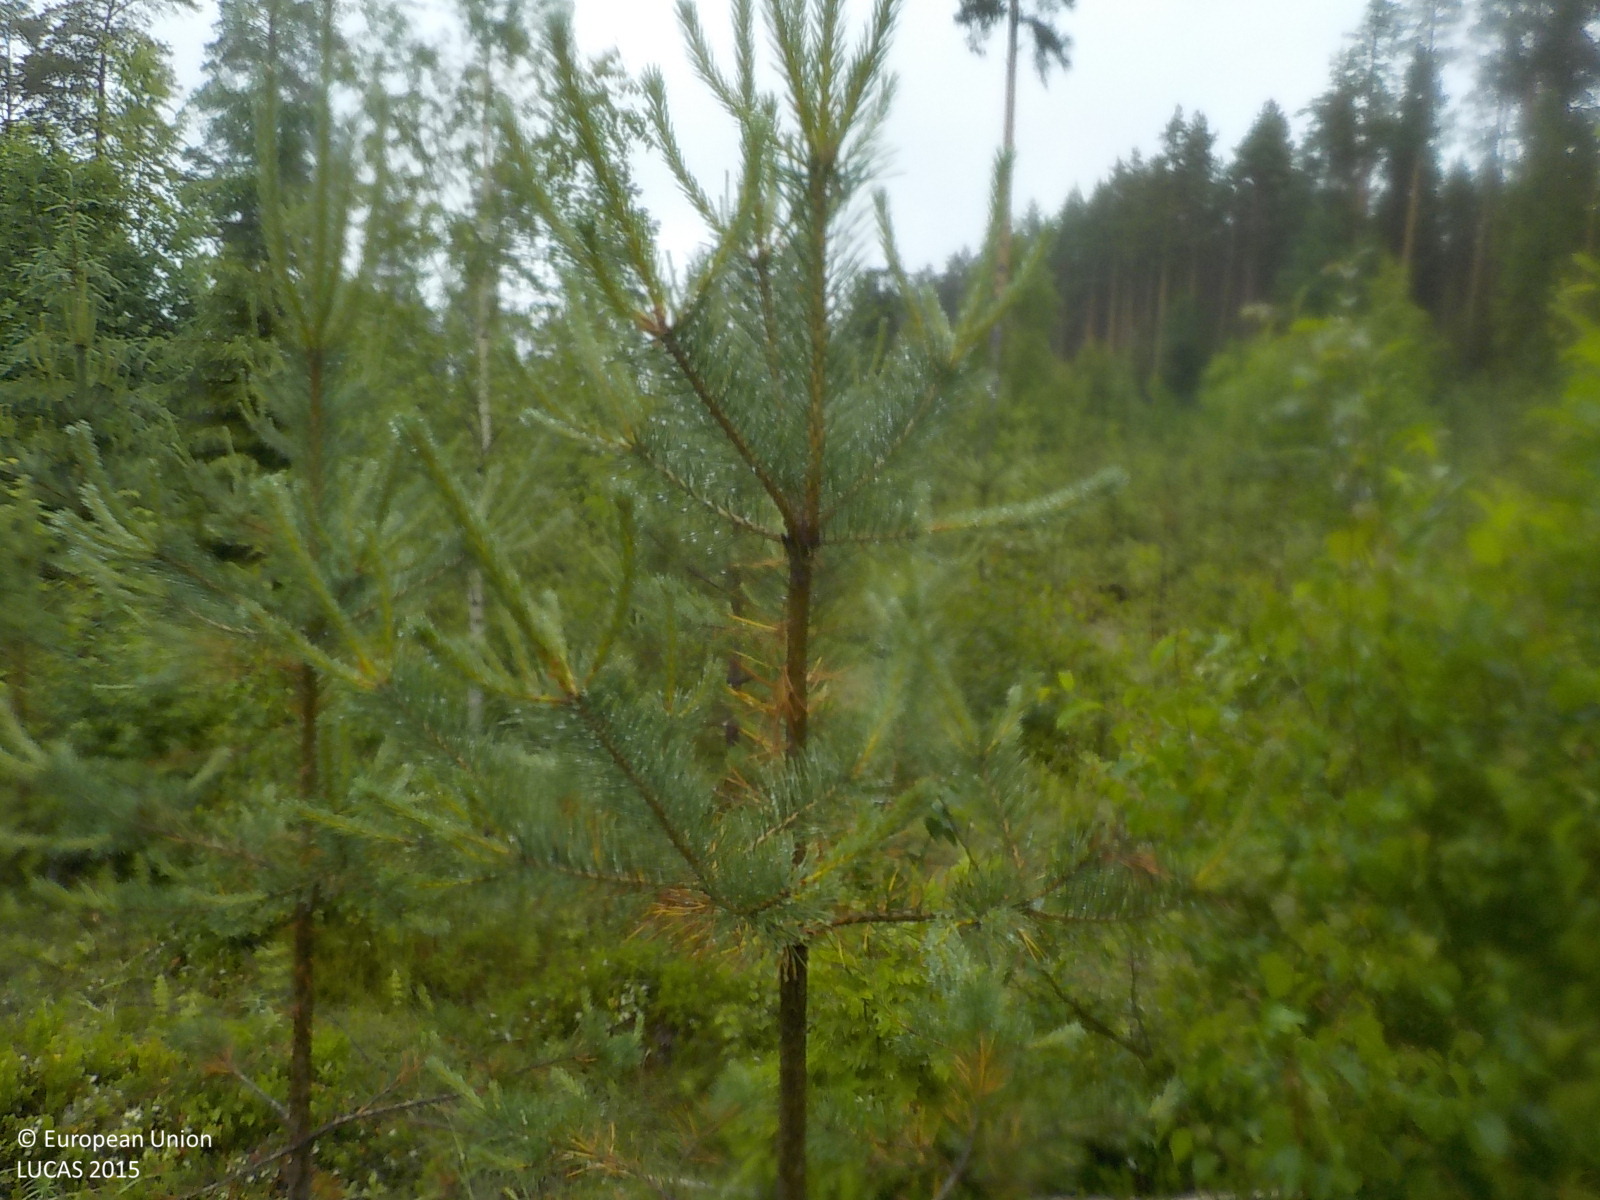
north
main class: Woodland
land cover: Pine dominated mixed woodland
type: boreal forest
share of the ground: > 75 %
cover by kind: coniferous forest trees 50 %, broadleaved forest trees 25 %, shrubs 25 %
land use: Forestry
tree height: < 5 m
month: July
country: SE
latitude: 63.1371
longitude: 17.0179
